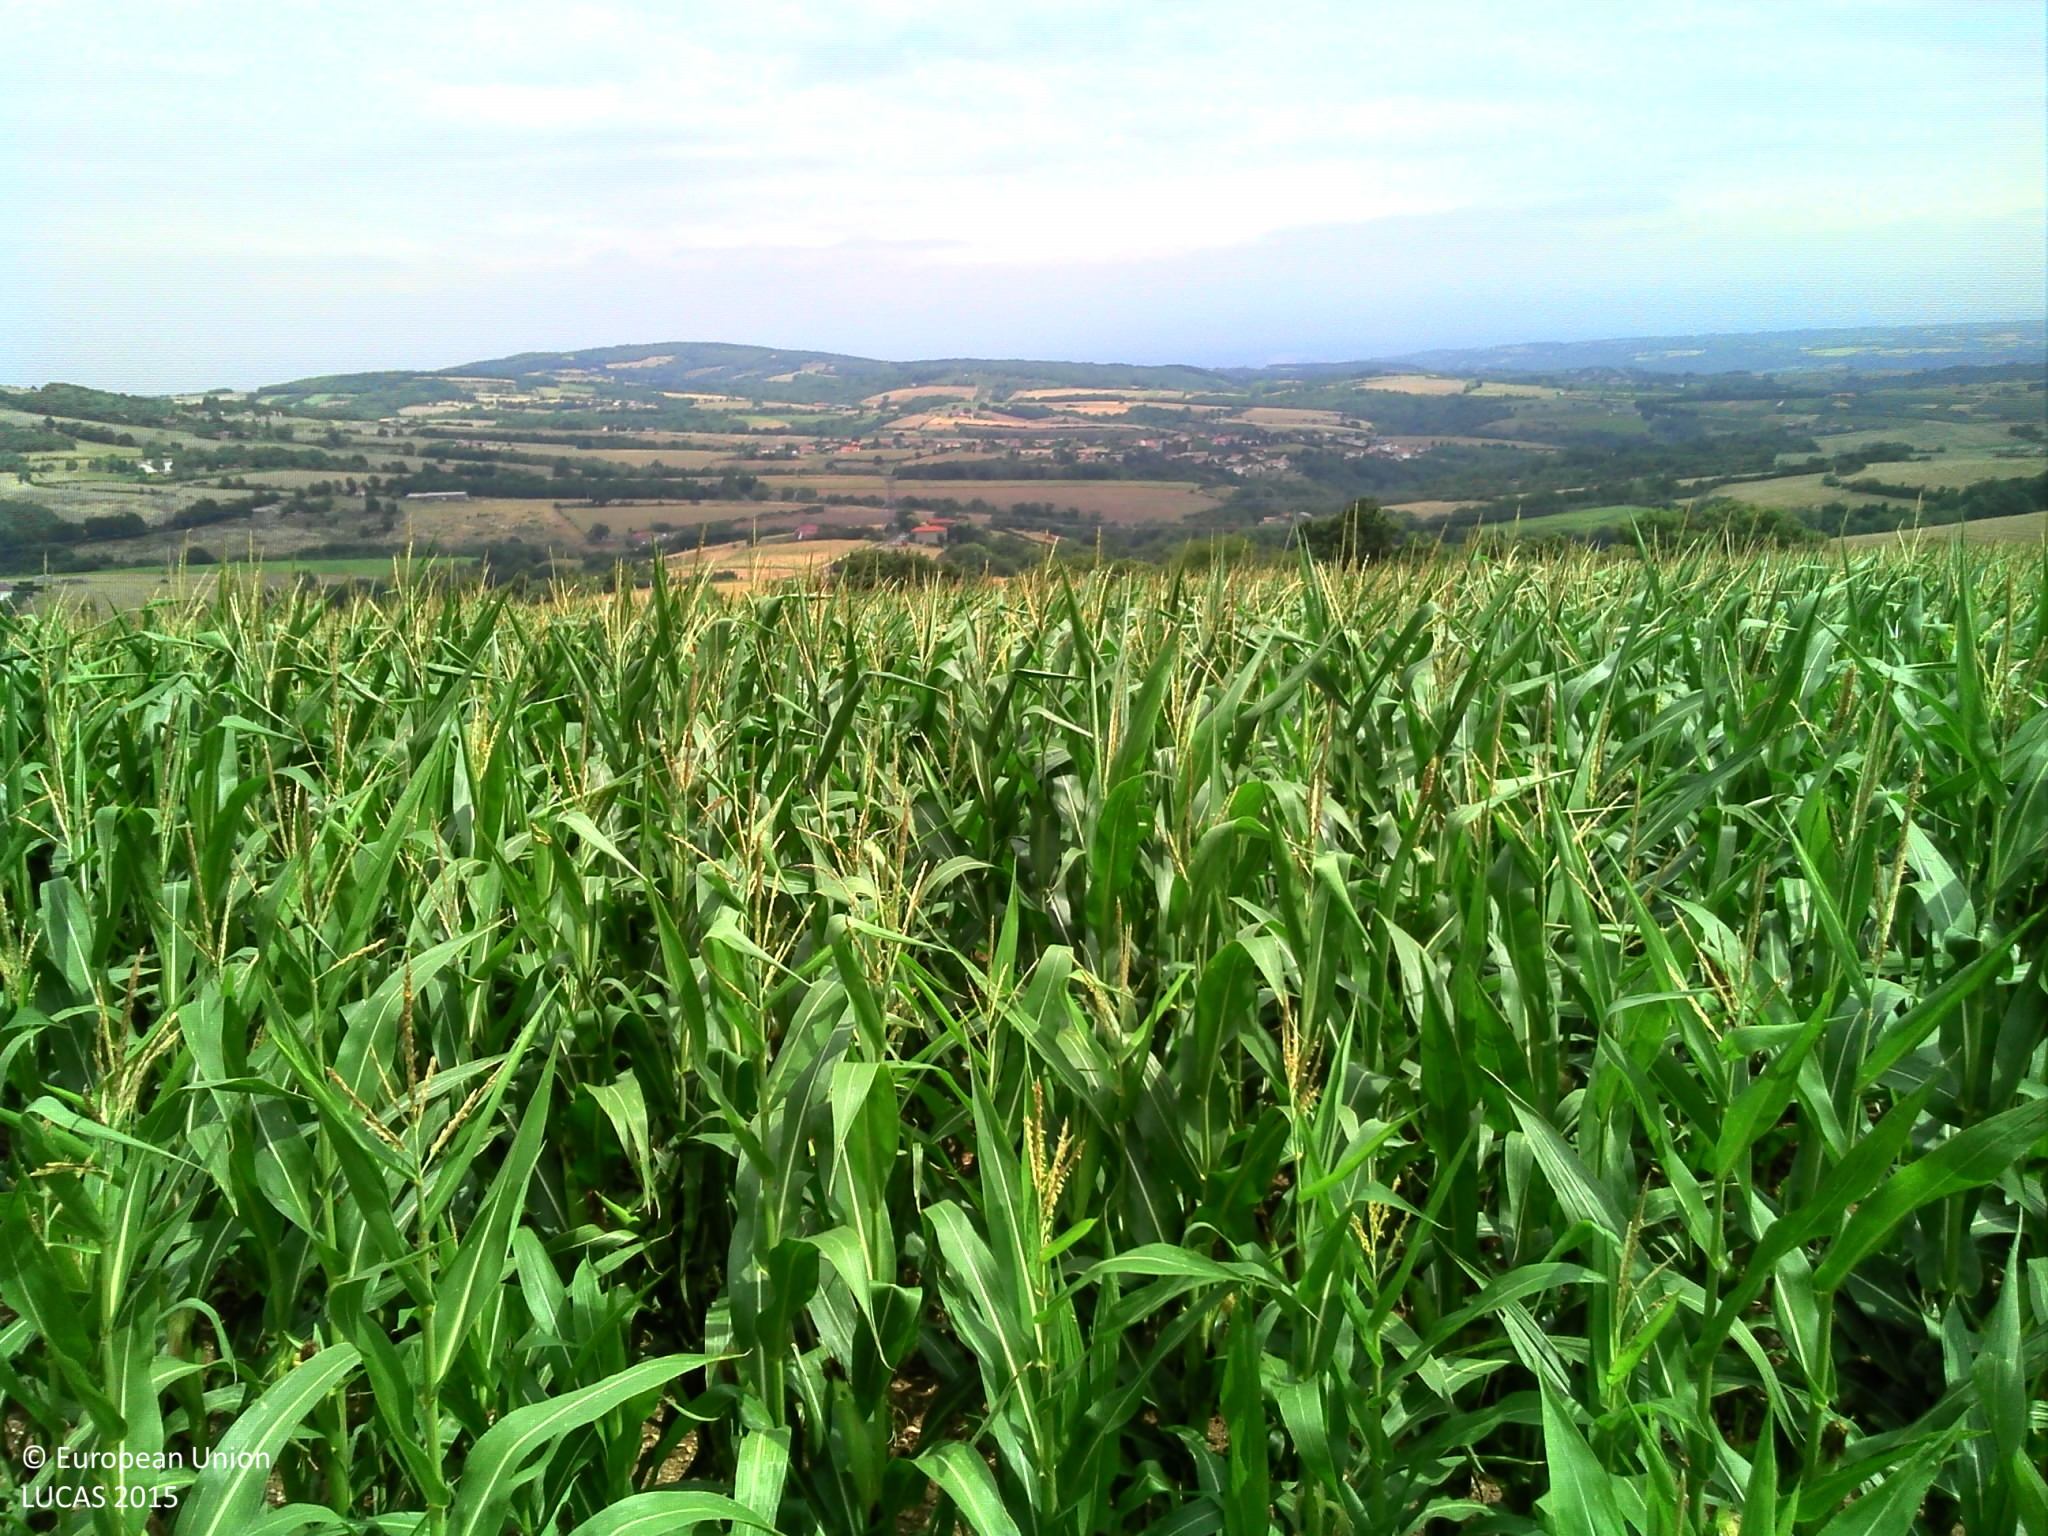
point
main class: Cropland
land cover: Maize
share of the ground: > 75 %
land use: Agriculture (excluding fallow land and kitchen gardens)
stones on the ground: 25 - 50 %
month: August
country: FR
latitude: 45.4986
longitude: 4.7188
